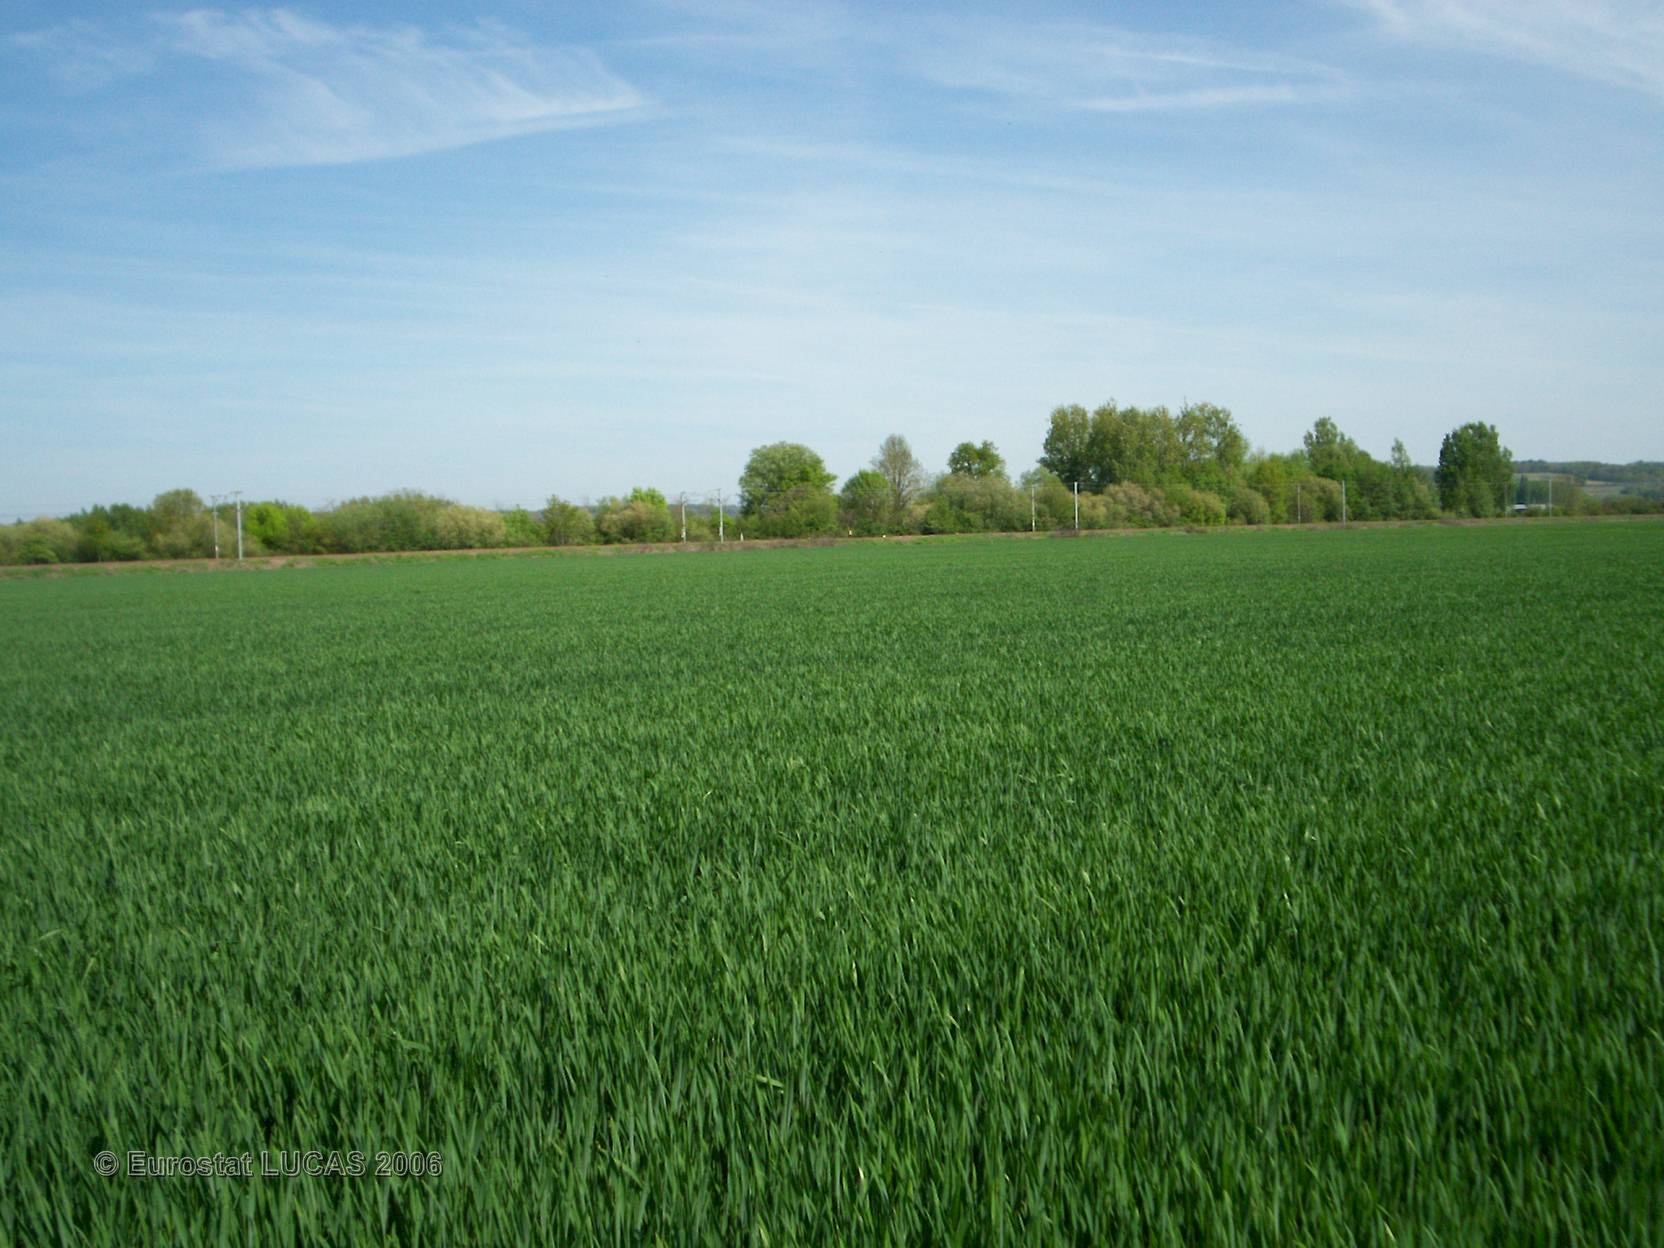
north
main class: Cropland
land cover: Common wheat
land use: Agriculture (excluding fallow land and kitchen gardens)
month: May
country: FR
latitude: 47.2659
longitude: 0.2631
